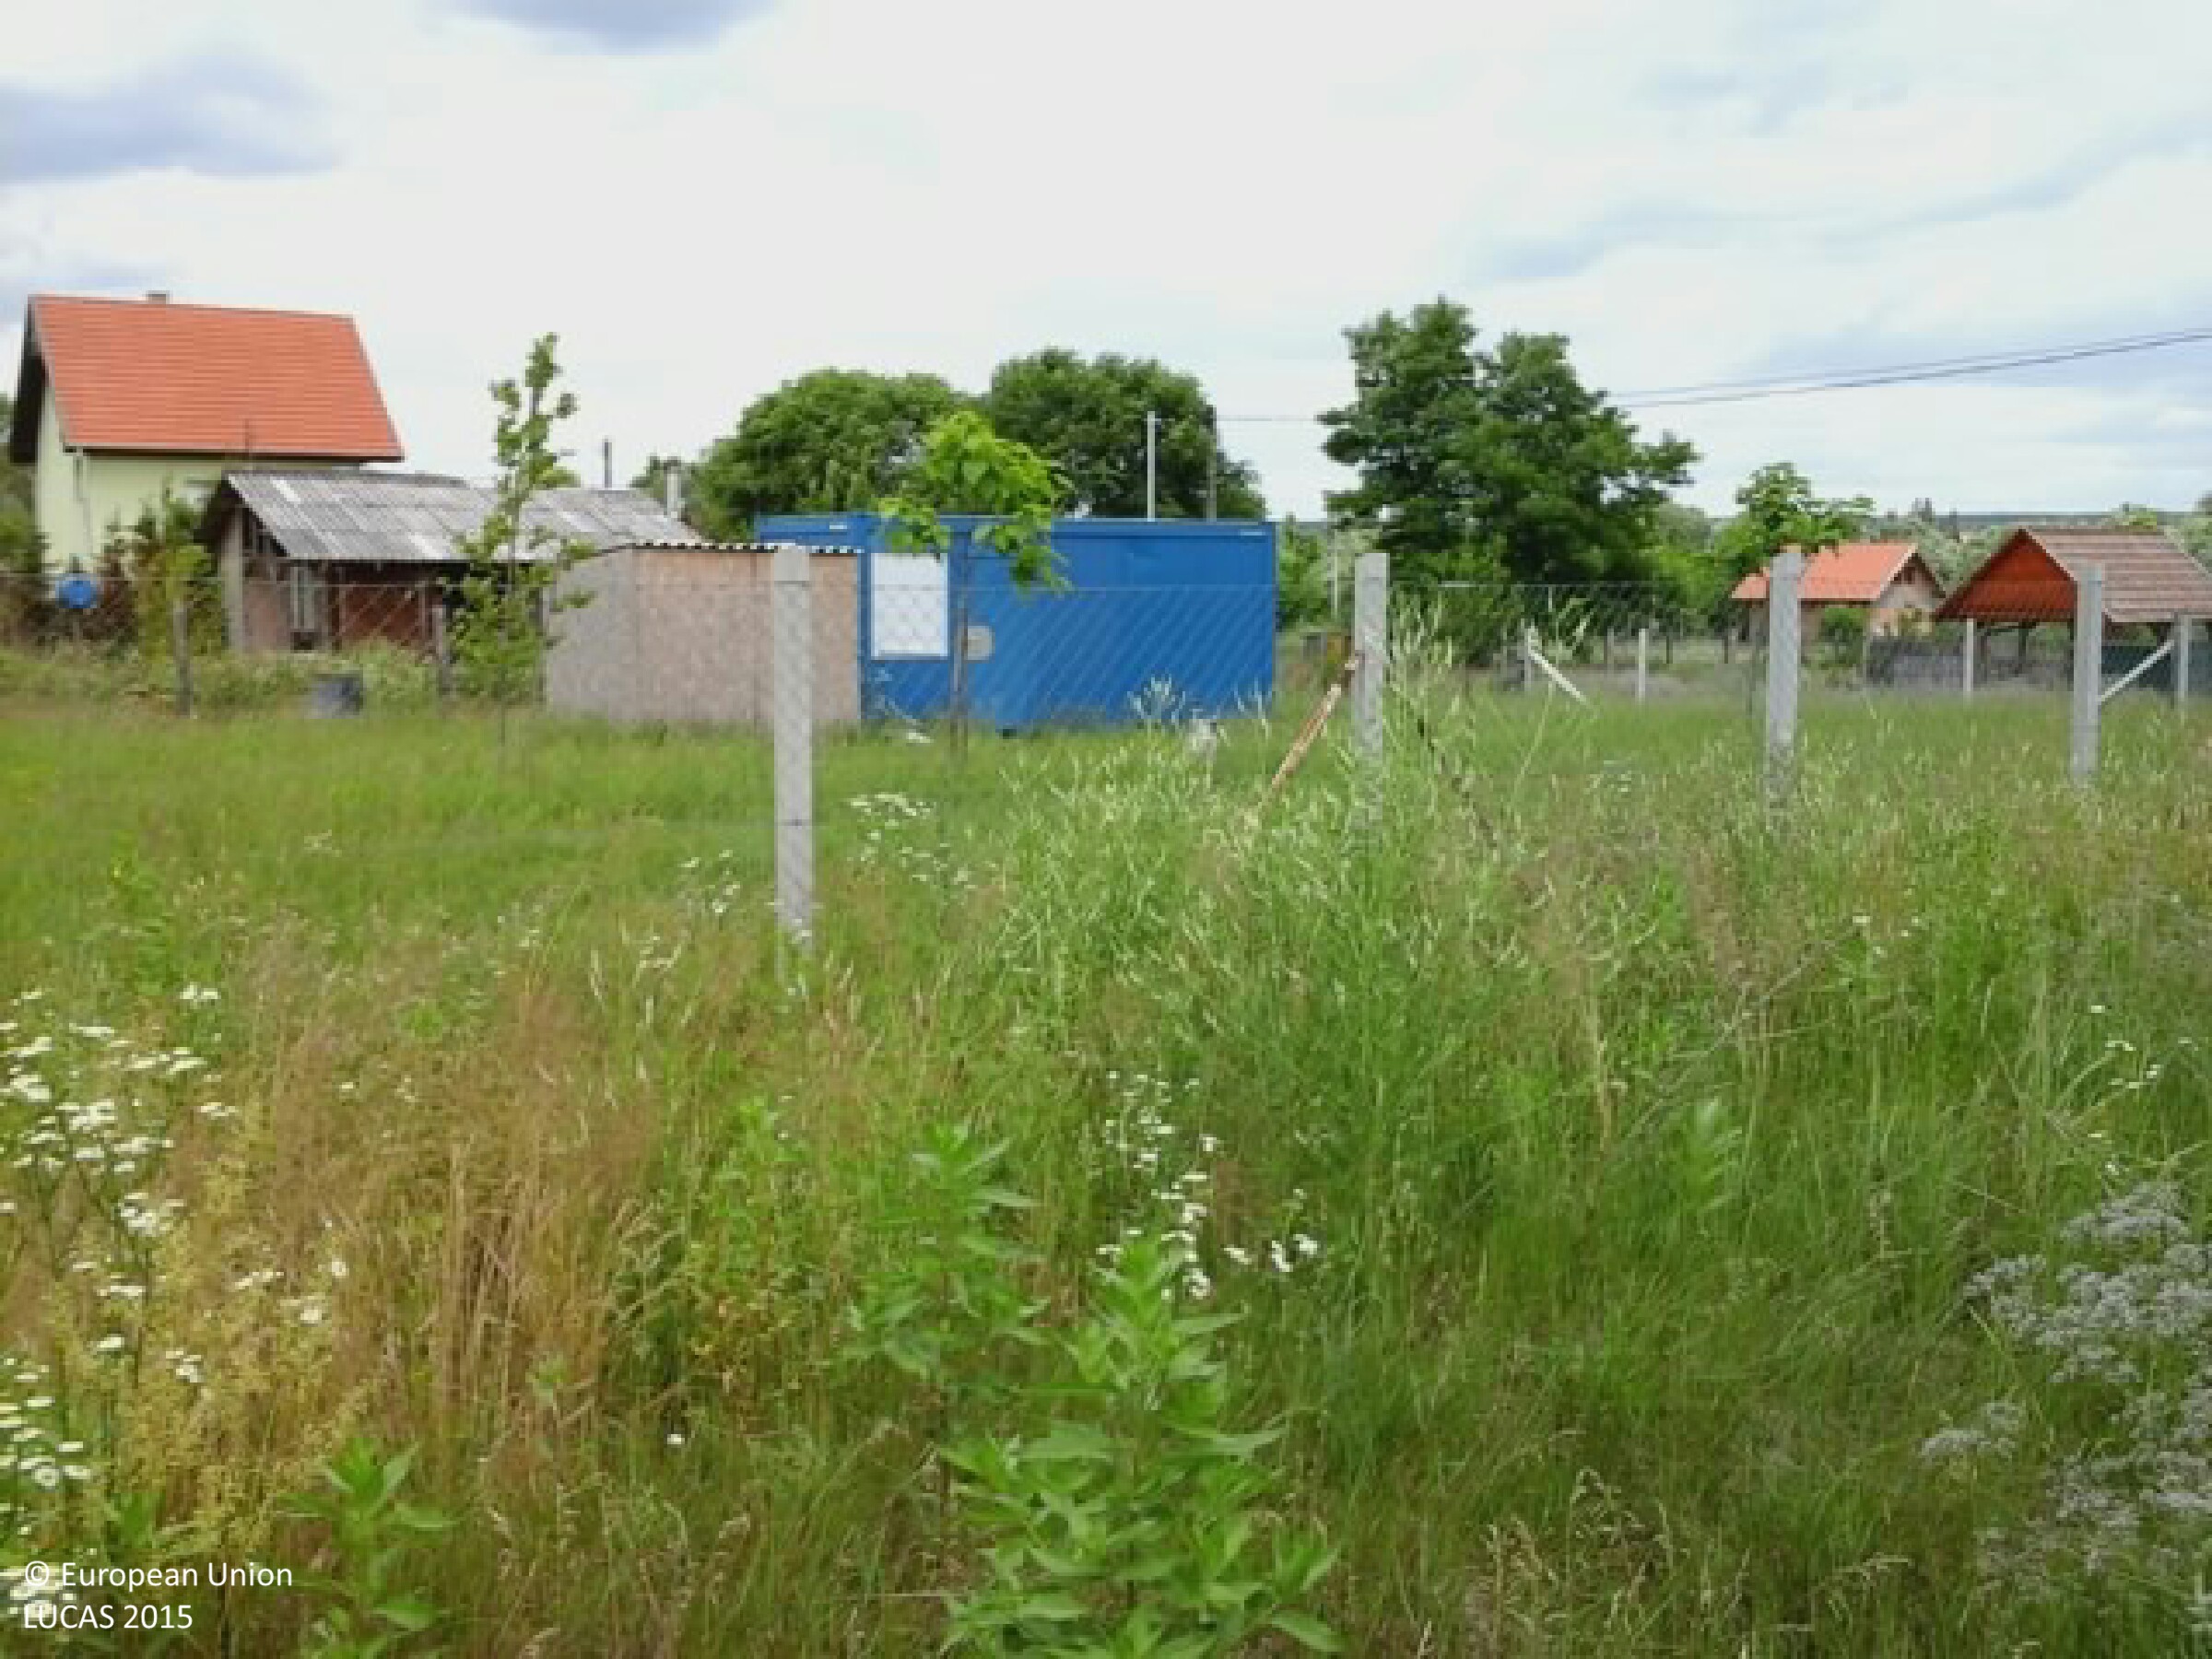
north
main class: Grassland
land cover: Spontaneously vegetated surfaces
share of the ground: > 75 %
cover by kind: herbaceous plants 100 %
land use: Fallow land
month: June
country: HU
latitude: 47.5325
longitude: 19.3854
